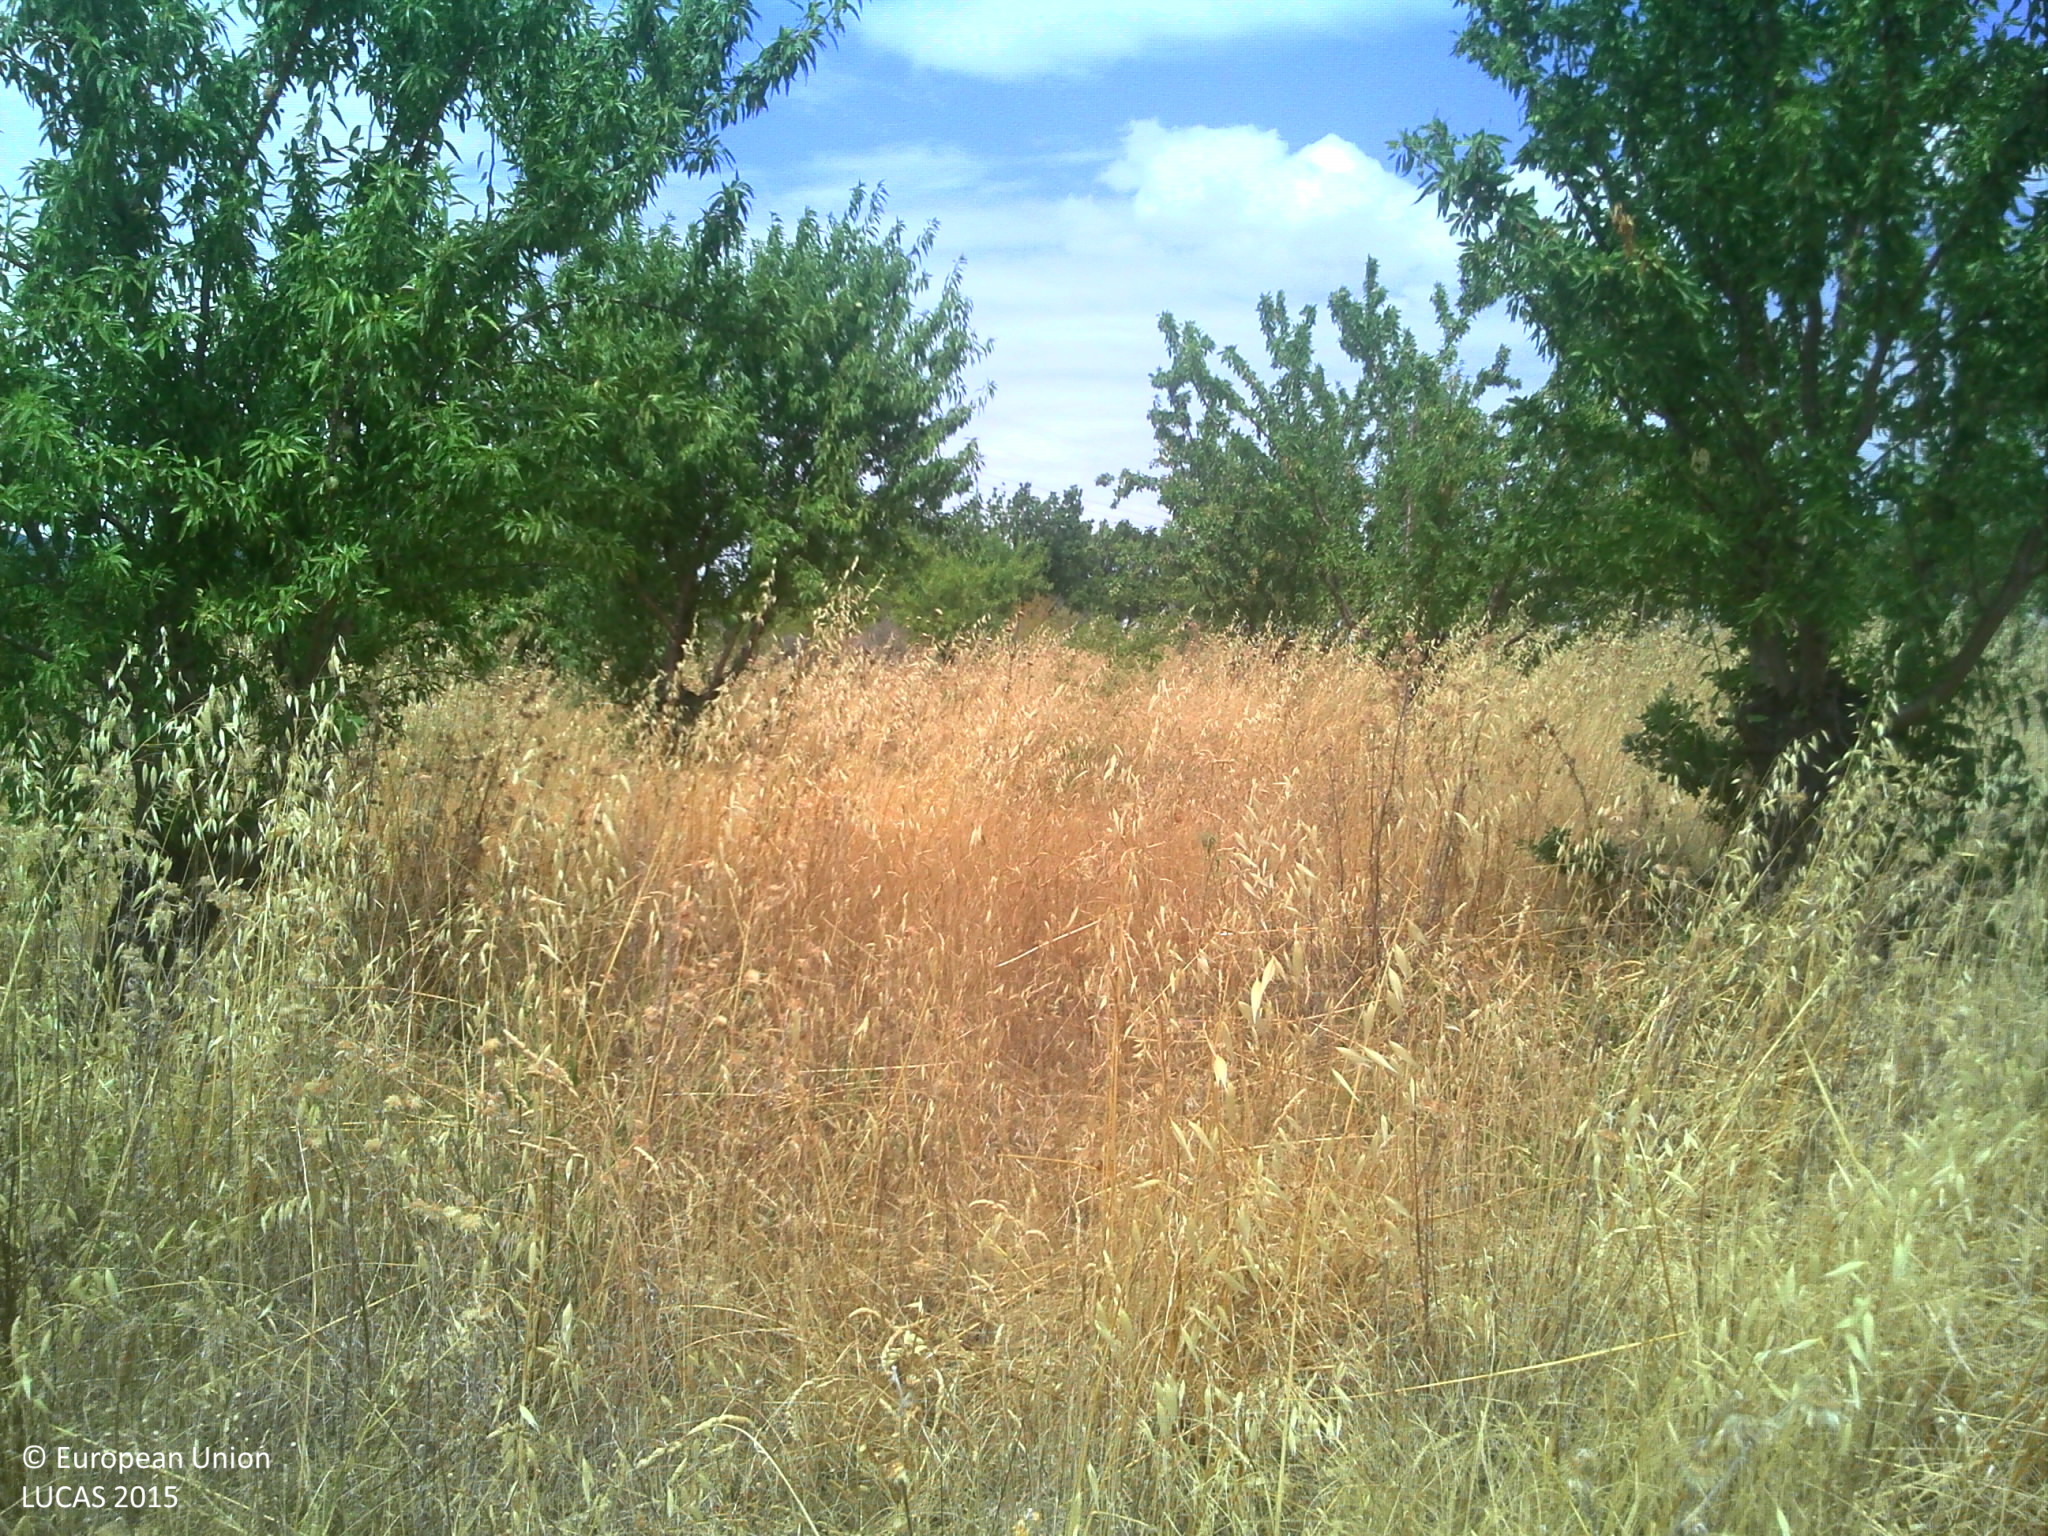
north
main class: Cropland
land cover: Nuts trees
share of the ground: 25 - 50 %
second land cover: Spontaneously vegetated surfaces
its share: > 75 %
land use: Agriculture (excluding fallow land and kitchen gardens)
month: July
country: FR
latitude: 43.4527
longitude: 3.1254
